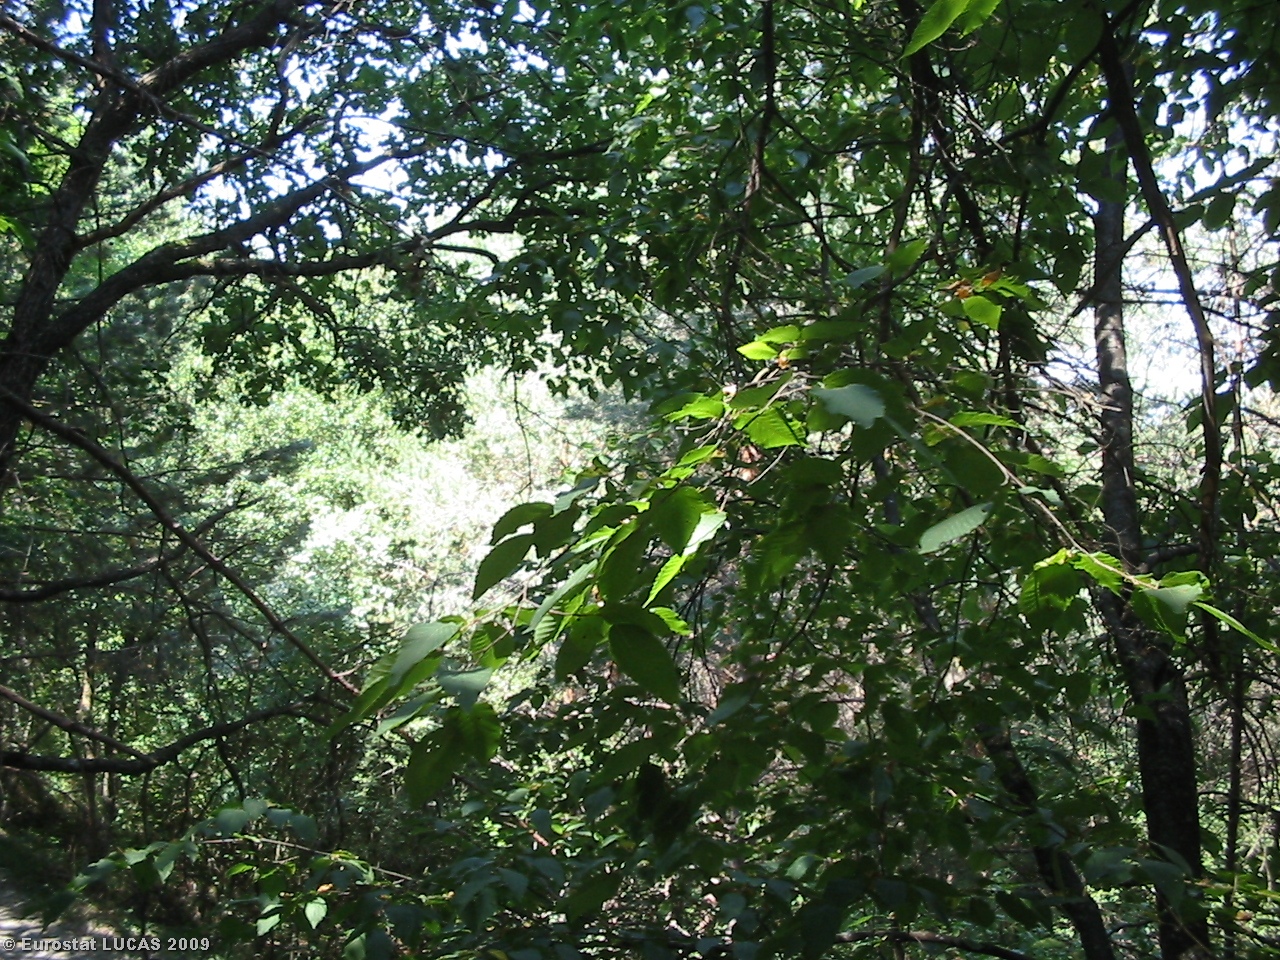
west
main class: Woodland
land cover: Mixed woodland
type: thermophilous deciduous forest
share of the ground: > 75 %
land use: Forestry
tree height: > 5 m
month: July
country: IT
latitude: 44.4582
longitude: 10.3386
